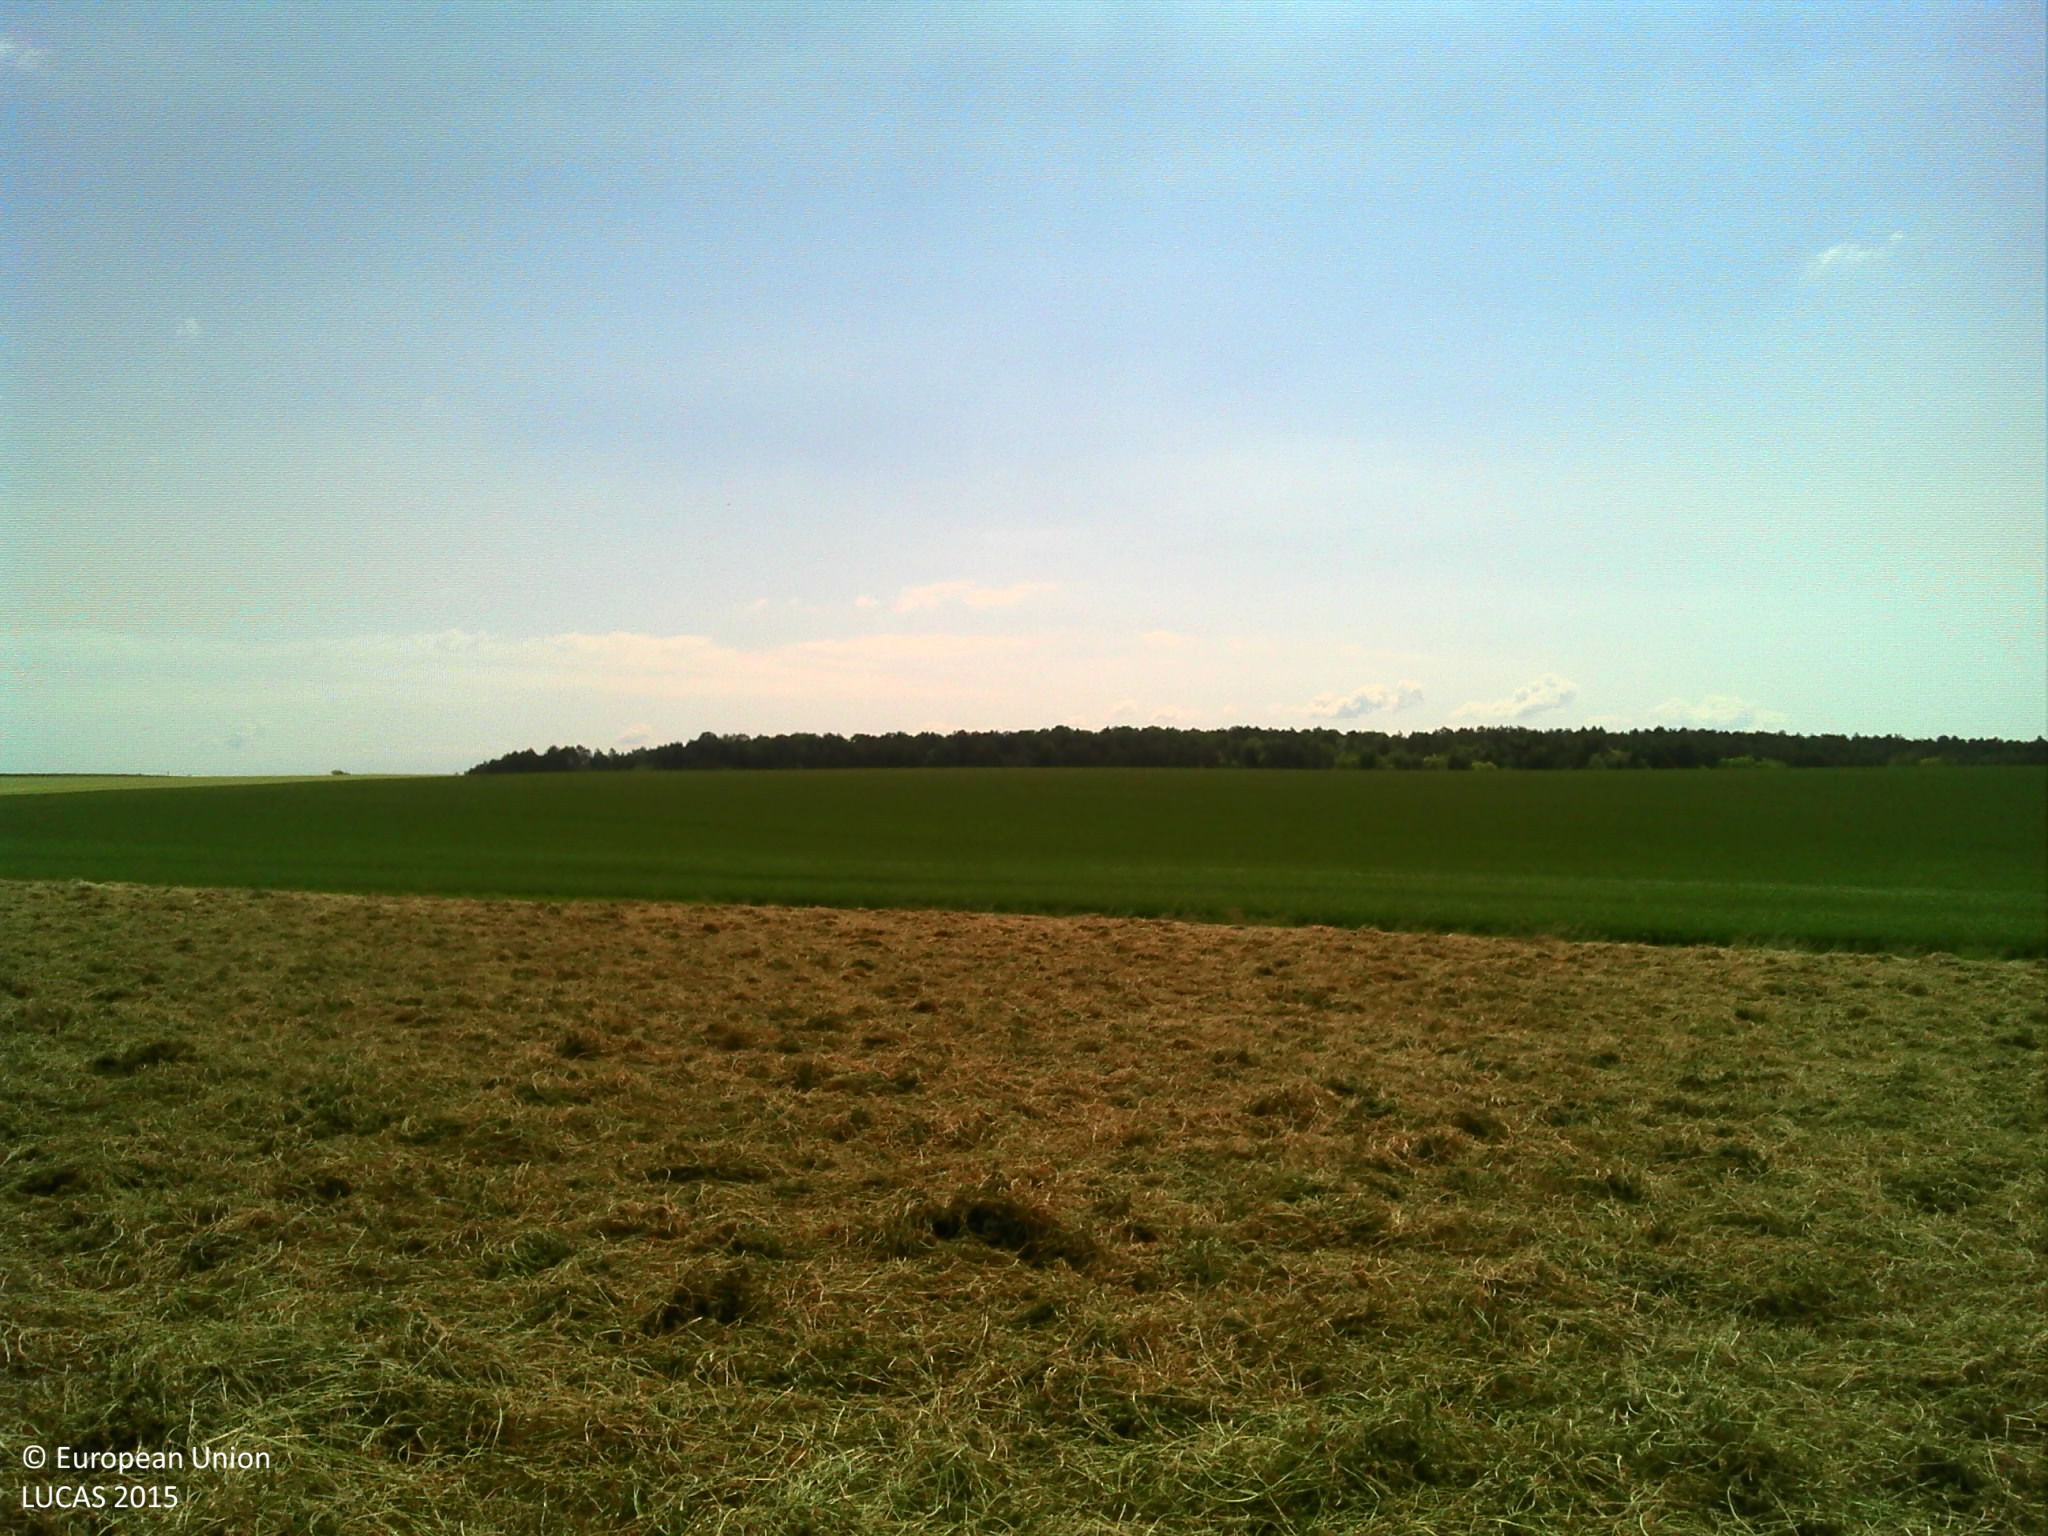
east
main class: Cropland
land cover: Lucerne
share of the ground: > 75 %
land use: Agriculture (excluding fallow land and kitchen gardens)
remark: Harvested field
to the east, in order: Lucerne; Grass margins; Ditches and canals; Grass margins; Common wheat; Grass margins; Tracks; Grass margins; Common wheat
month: May
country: FR
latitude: 47.3986
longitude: 5.2174
